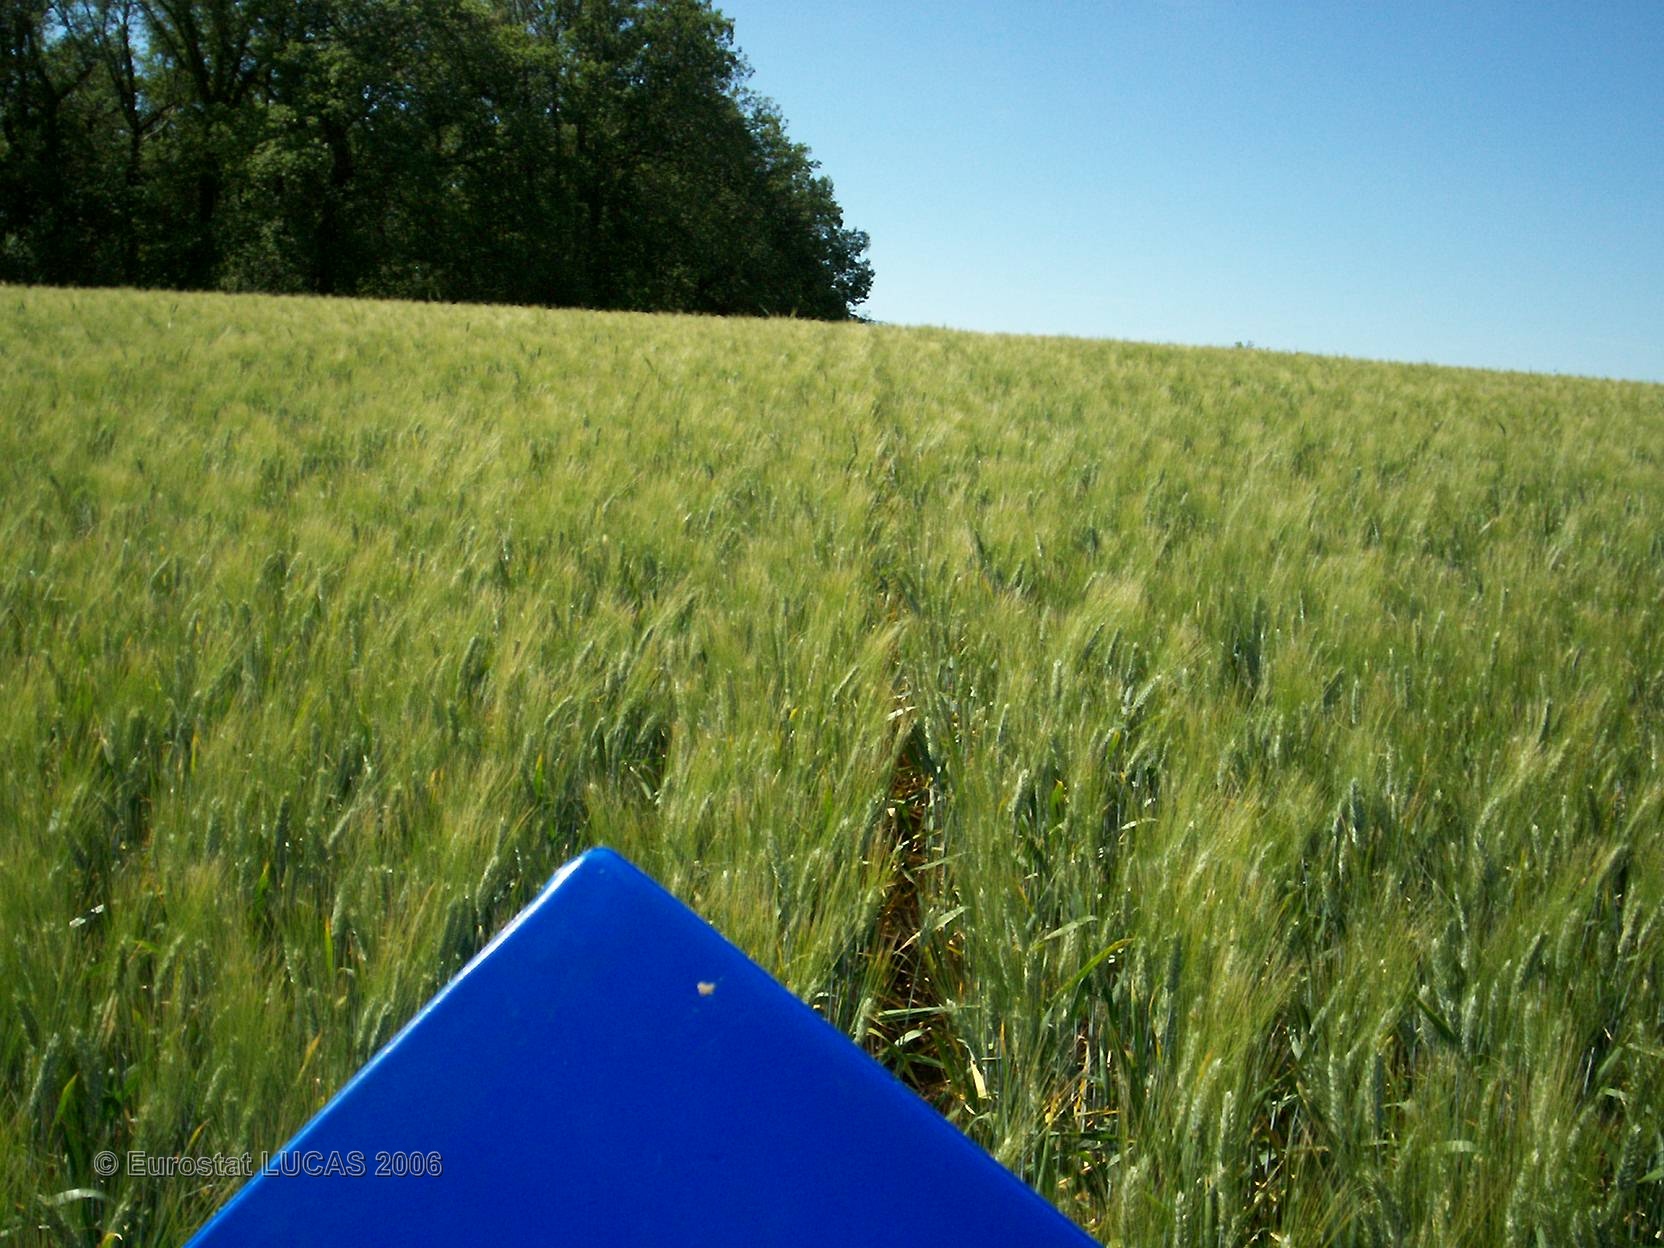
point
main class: Cropland
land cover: Durum wheat
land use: Agriculture (excluding fallow land and kitchen gardens)
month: June
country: FR
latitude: 43.9246
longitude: 0.8181
